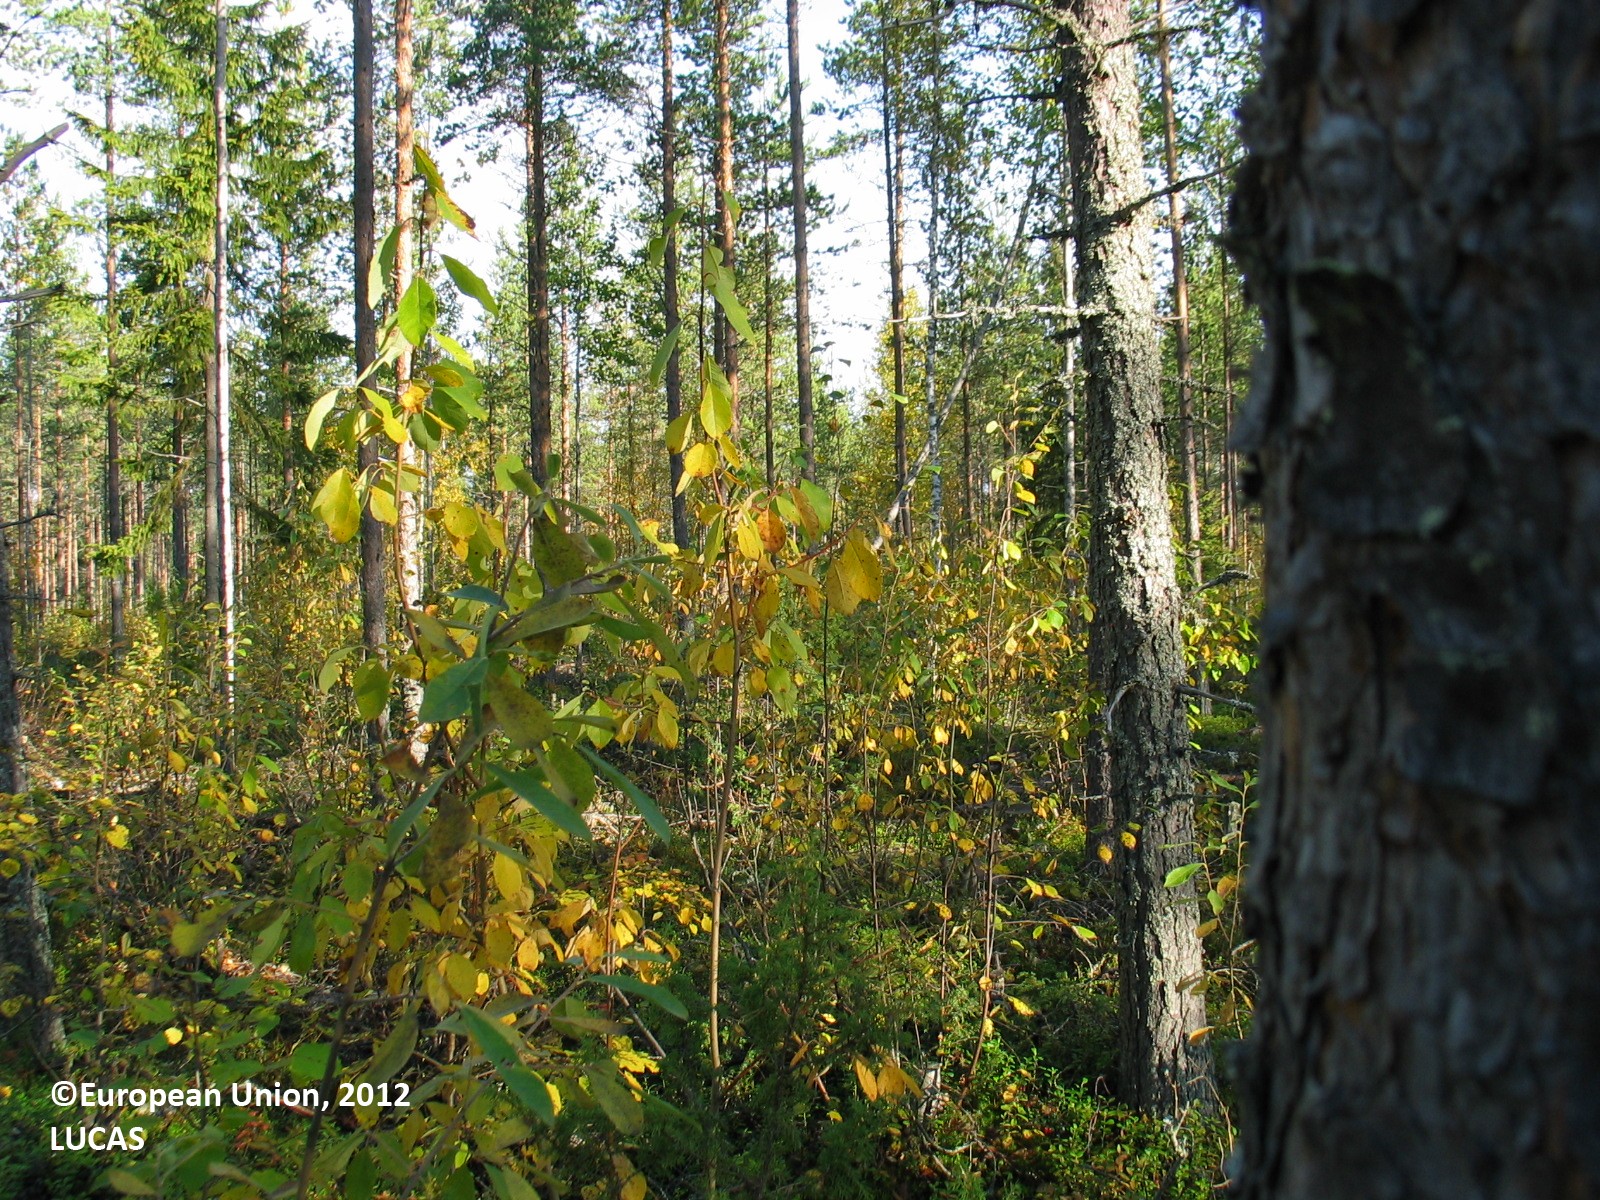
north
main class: Woodland
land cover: Pine dominated coniferous woodland
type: boreal forest
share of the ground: 25 - 50 %
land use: Forestry
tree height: > 5 m
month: September
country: FI
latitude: 65.5091
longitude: 25.5798
